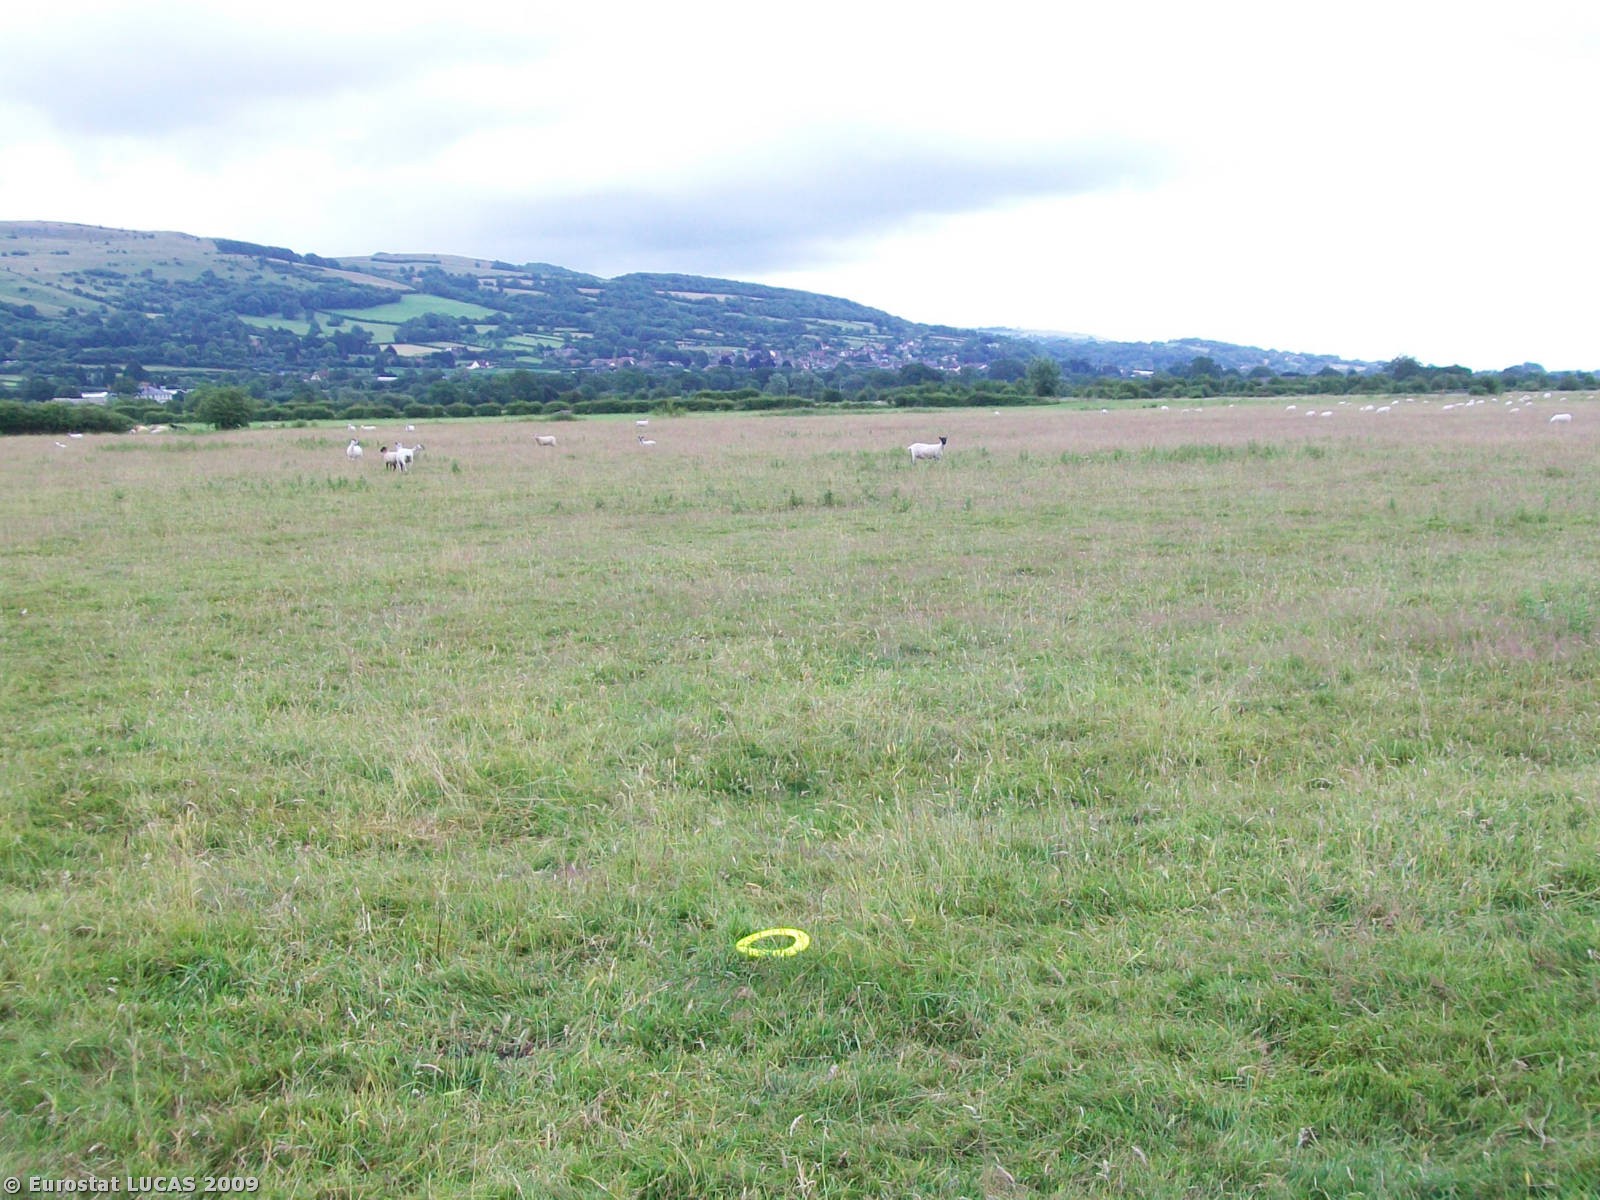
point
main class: Grassland
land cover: Grassland without tree/shrub cover
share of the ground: > 75 %
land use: Agriculture (excluding fallow land and kitchen gardens)
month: July
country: GB
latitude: 51.2639
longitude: -2.7831
